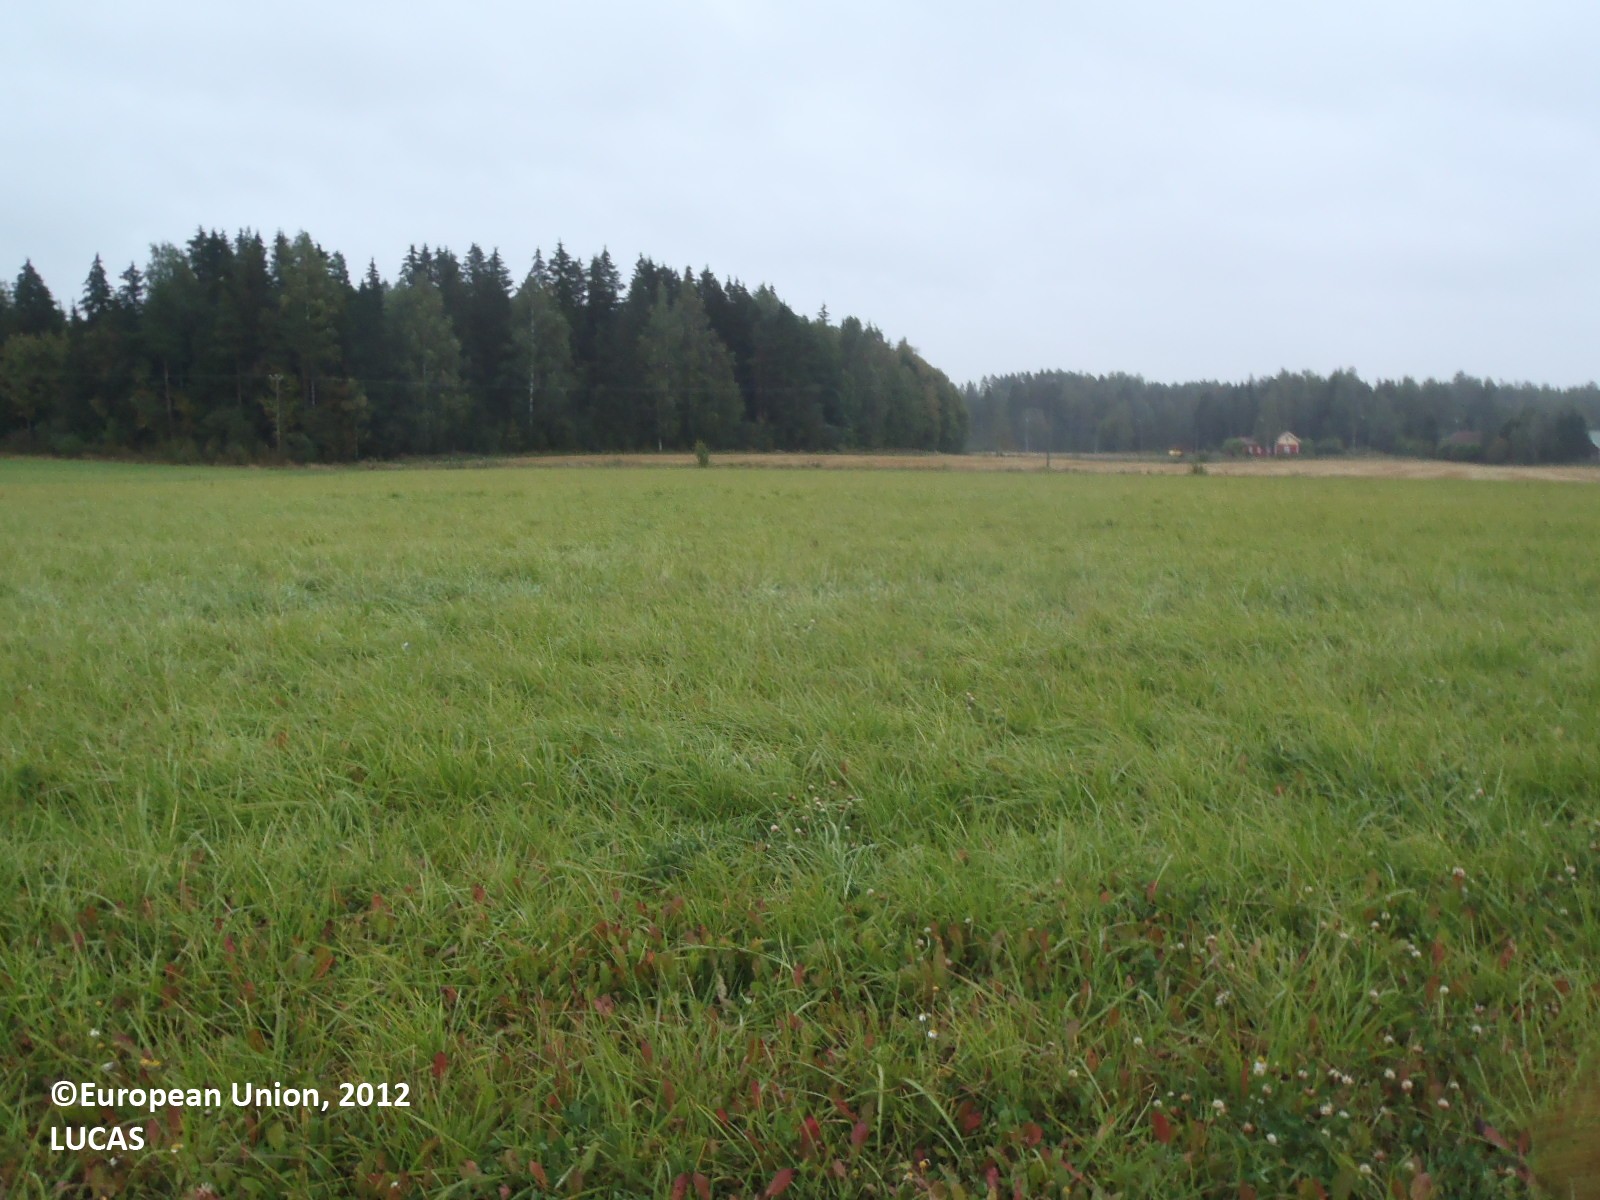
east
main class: Cropland
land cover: Oats
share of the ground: > 75 %
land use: Agriculture (excluding fallow land and kitchen gardens)
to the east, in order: Oats; Grass margins; Ditches and canals; Grass margins; Broadleaved woodland; Ditches and canals; Grass margins; Oats; Grass margins; Ditches and canals; Temporary grasslands
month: September
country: FI
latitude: 61.2499
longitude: 22.6855
